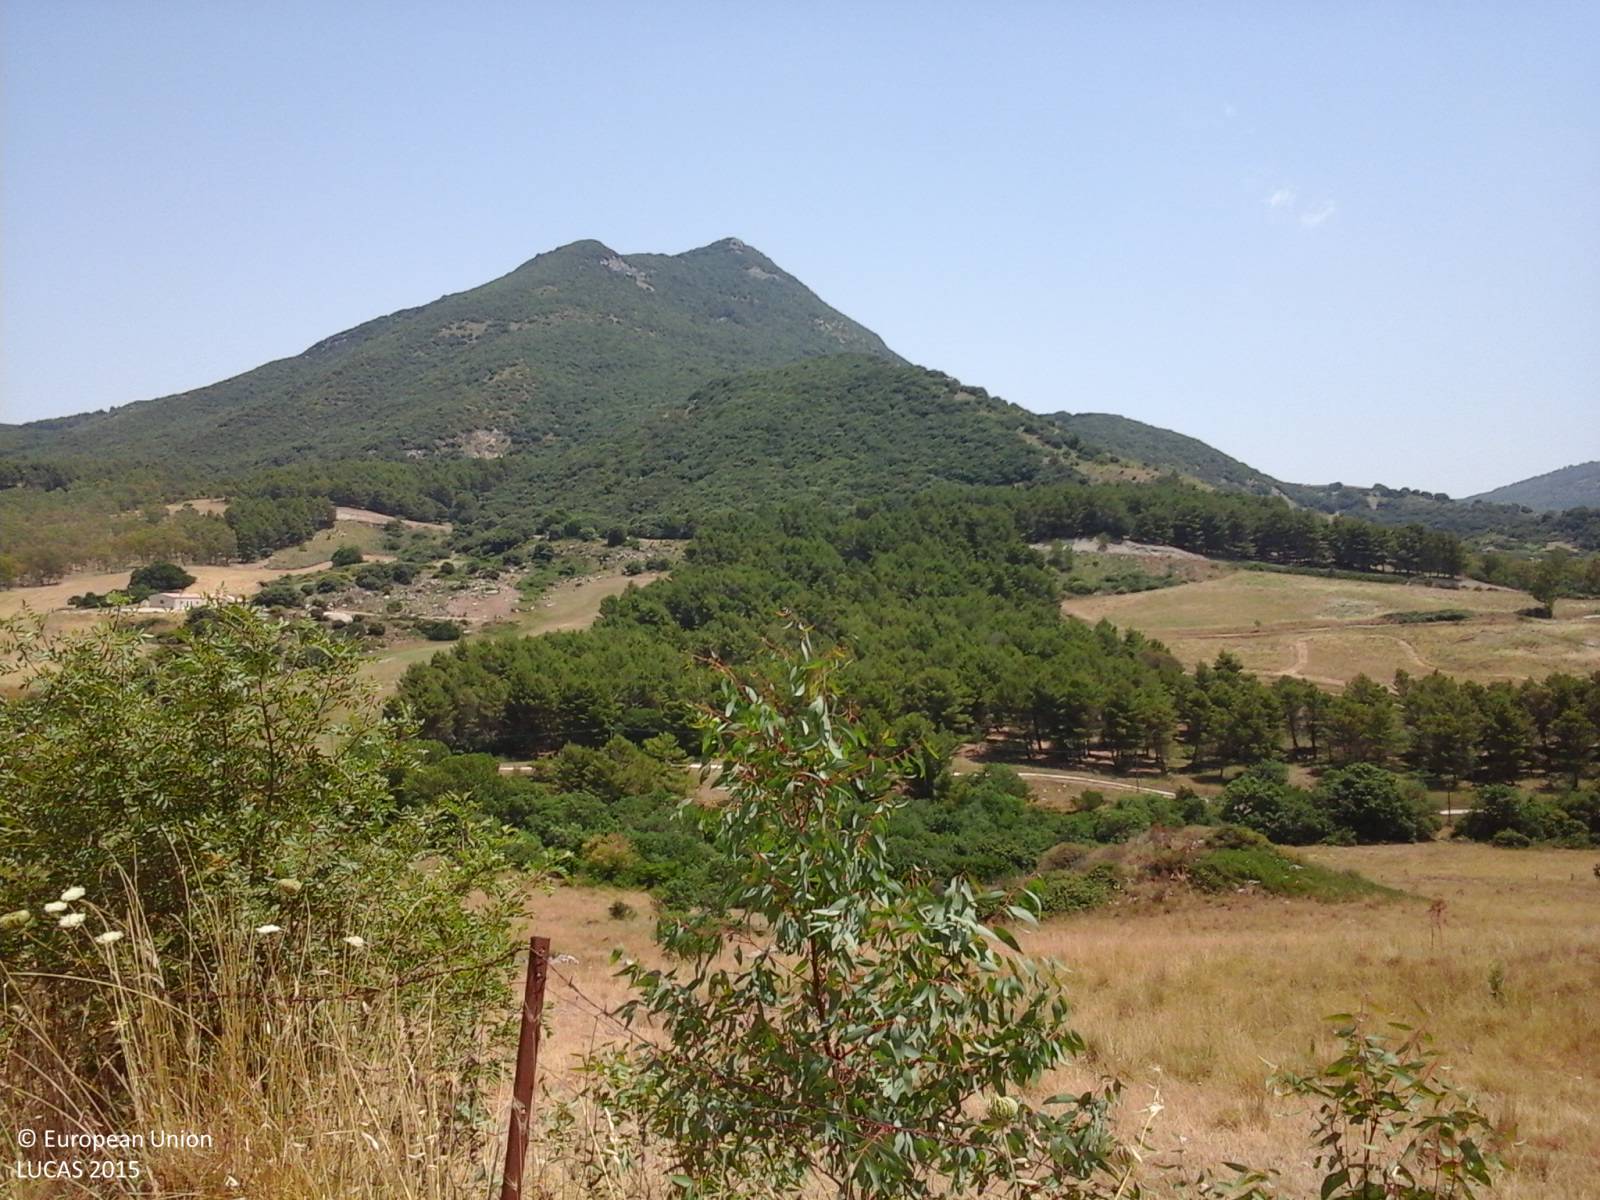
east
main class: Grassland
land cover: Grassland without tree/shrub cover
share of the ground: > 75 %
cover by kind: herbaceous plants 100 %
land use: Abandoned areas
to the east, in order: Grassland without tree/shrub cover; Fences; Grass margins; Grassland without tree/shrub cover; Tracks; Grassland without tree/shrub cover; Broadleaved woodland
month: July
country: IT
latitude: 37.7202
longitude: 13.4799
